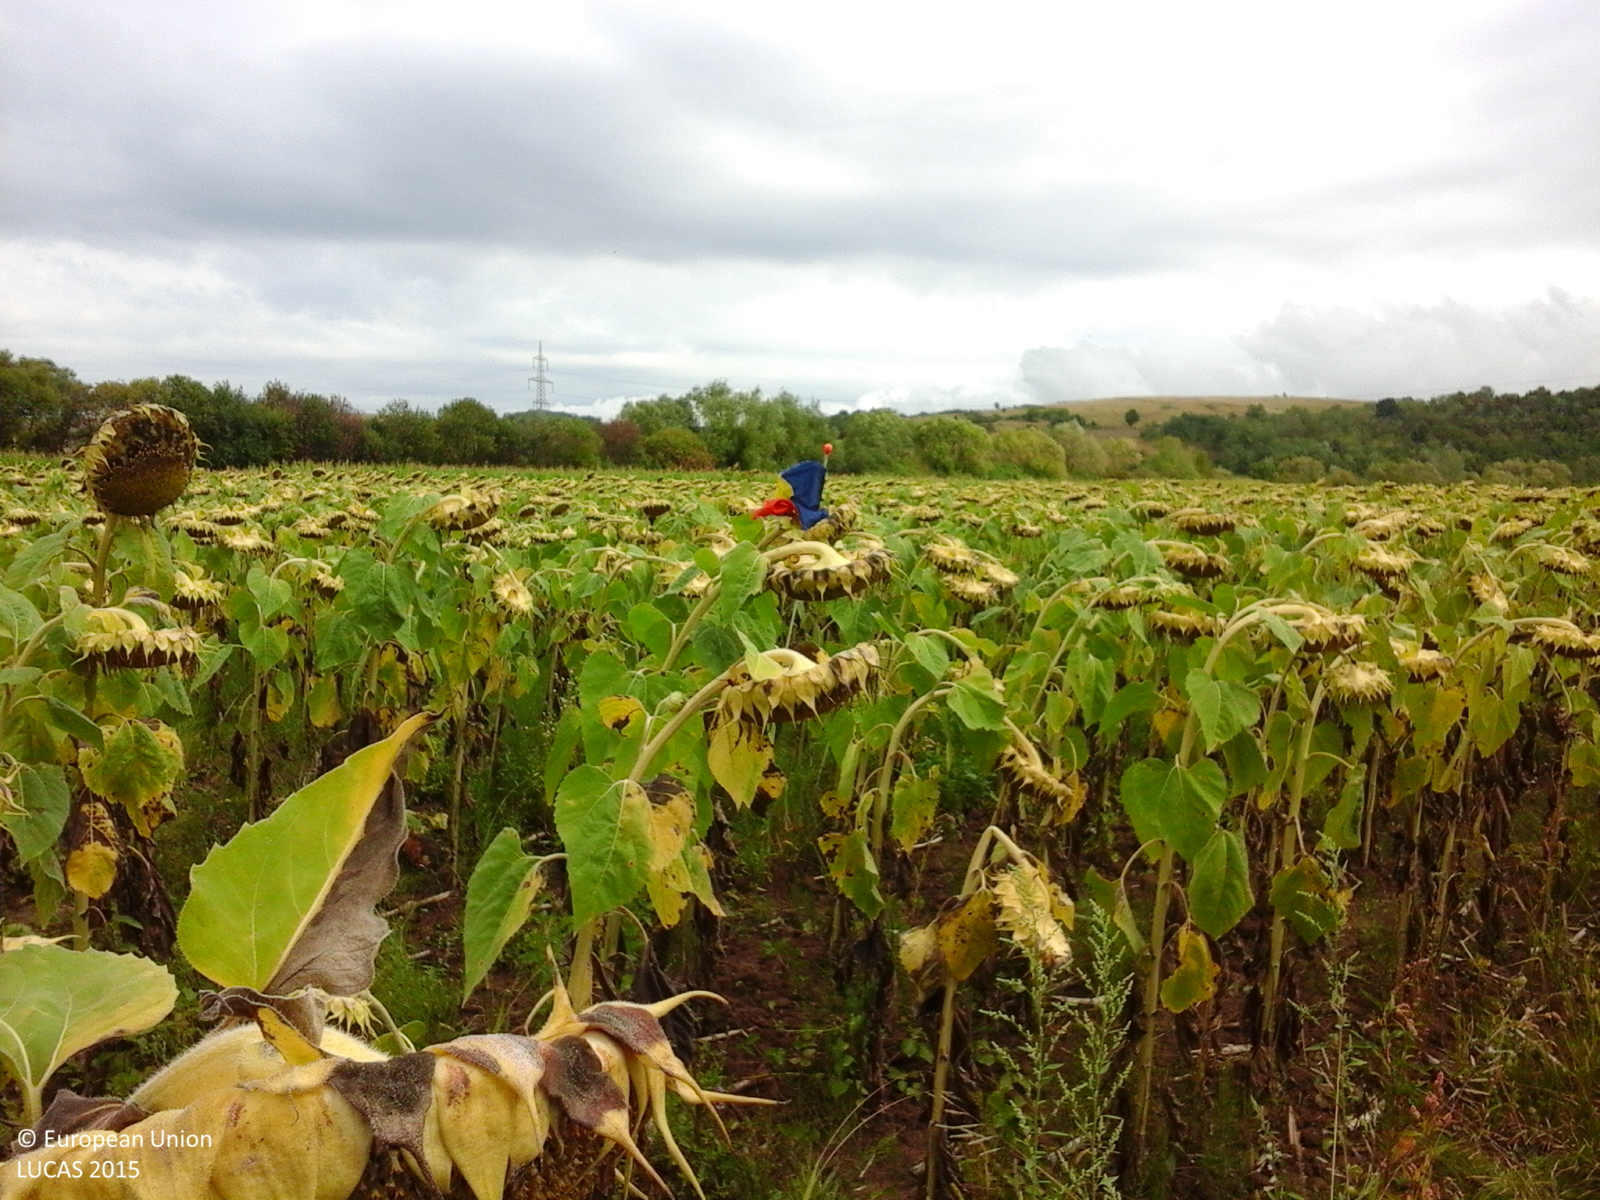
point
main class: Cropland
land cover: Sunflower
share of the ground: > 75 %
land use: Agriculture (excluding fallow land and kitchen gardens)
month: August
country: RO
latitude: 45.4389
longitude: 21.6543
